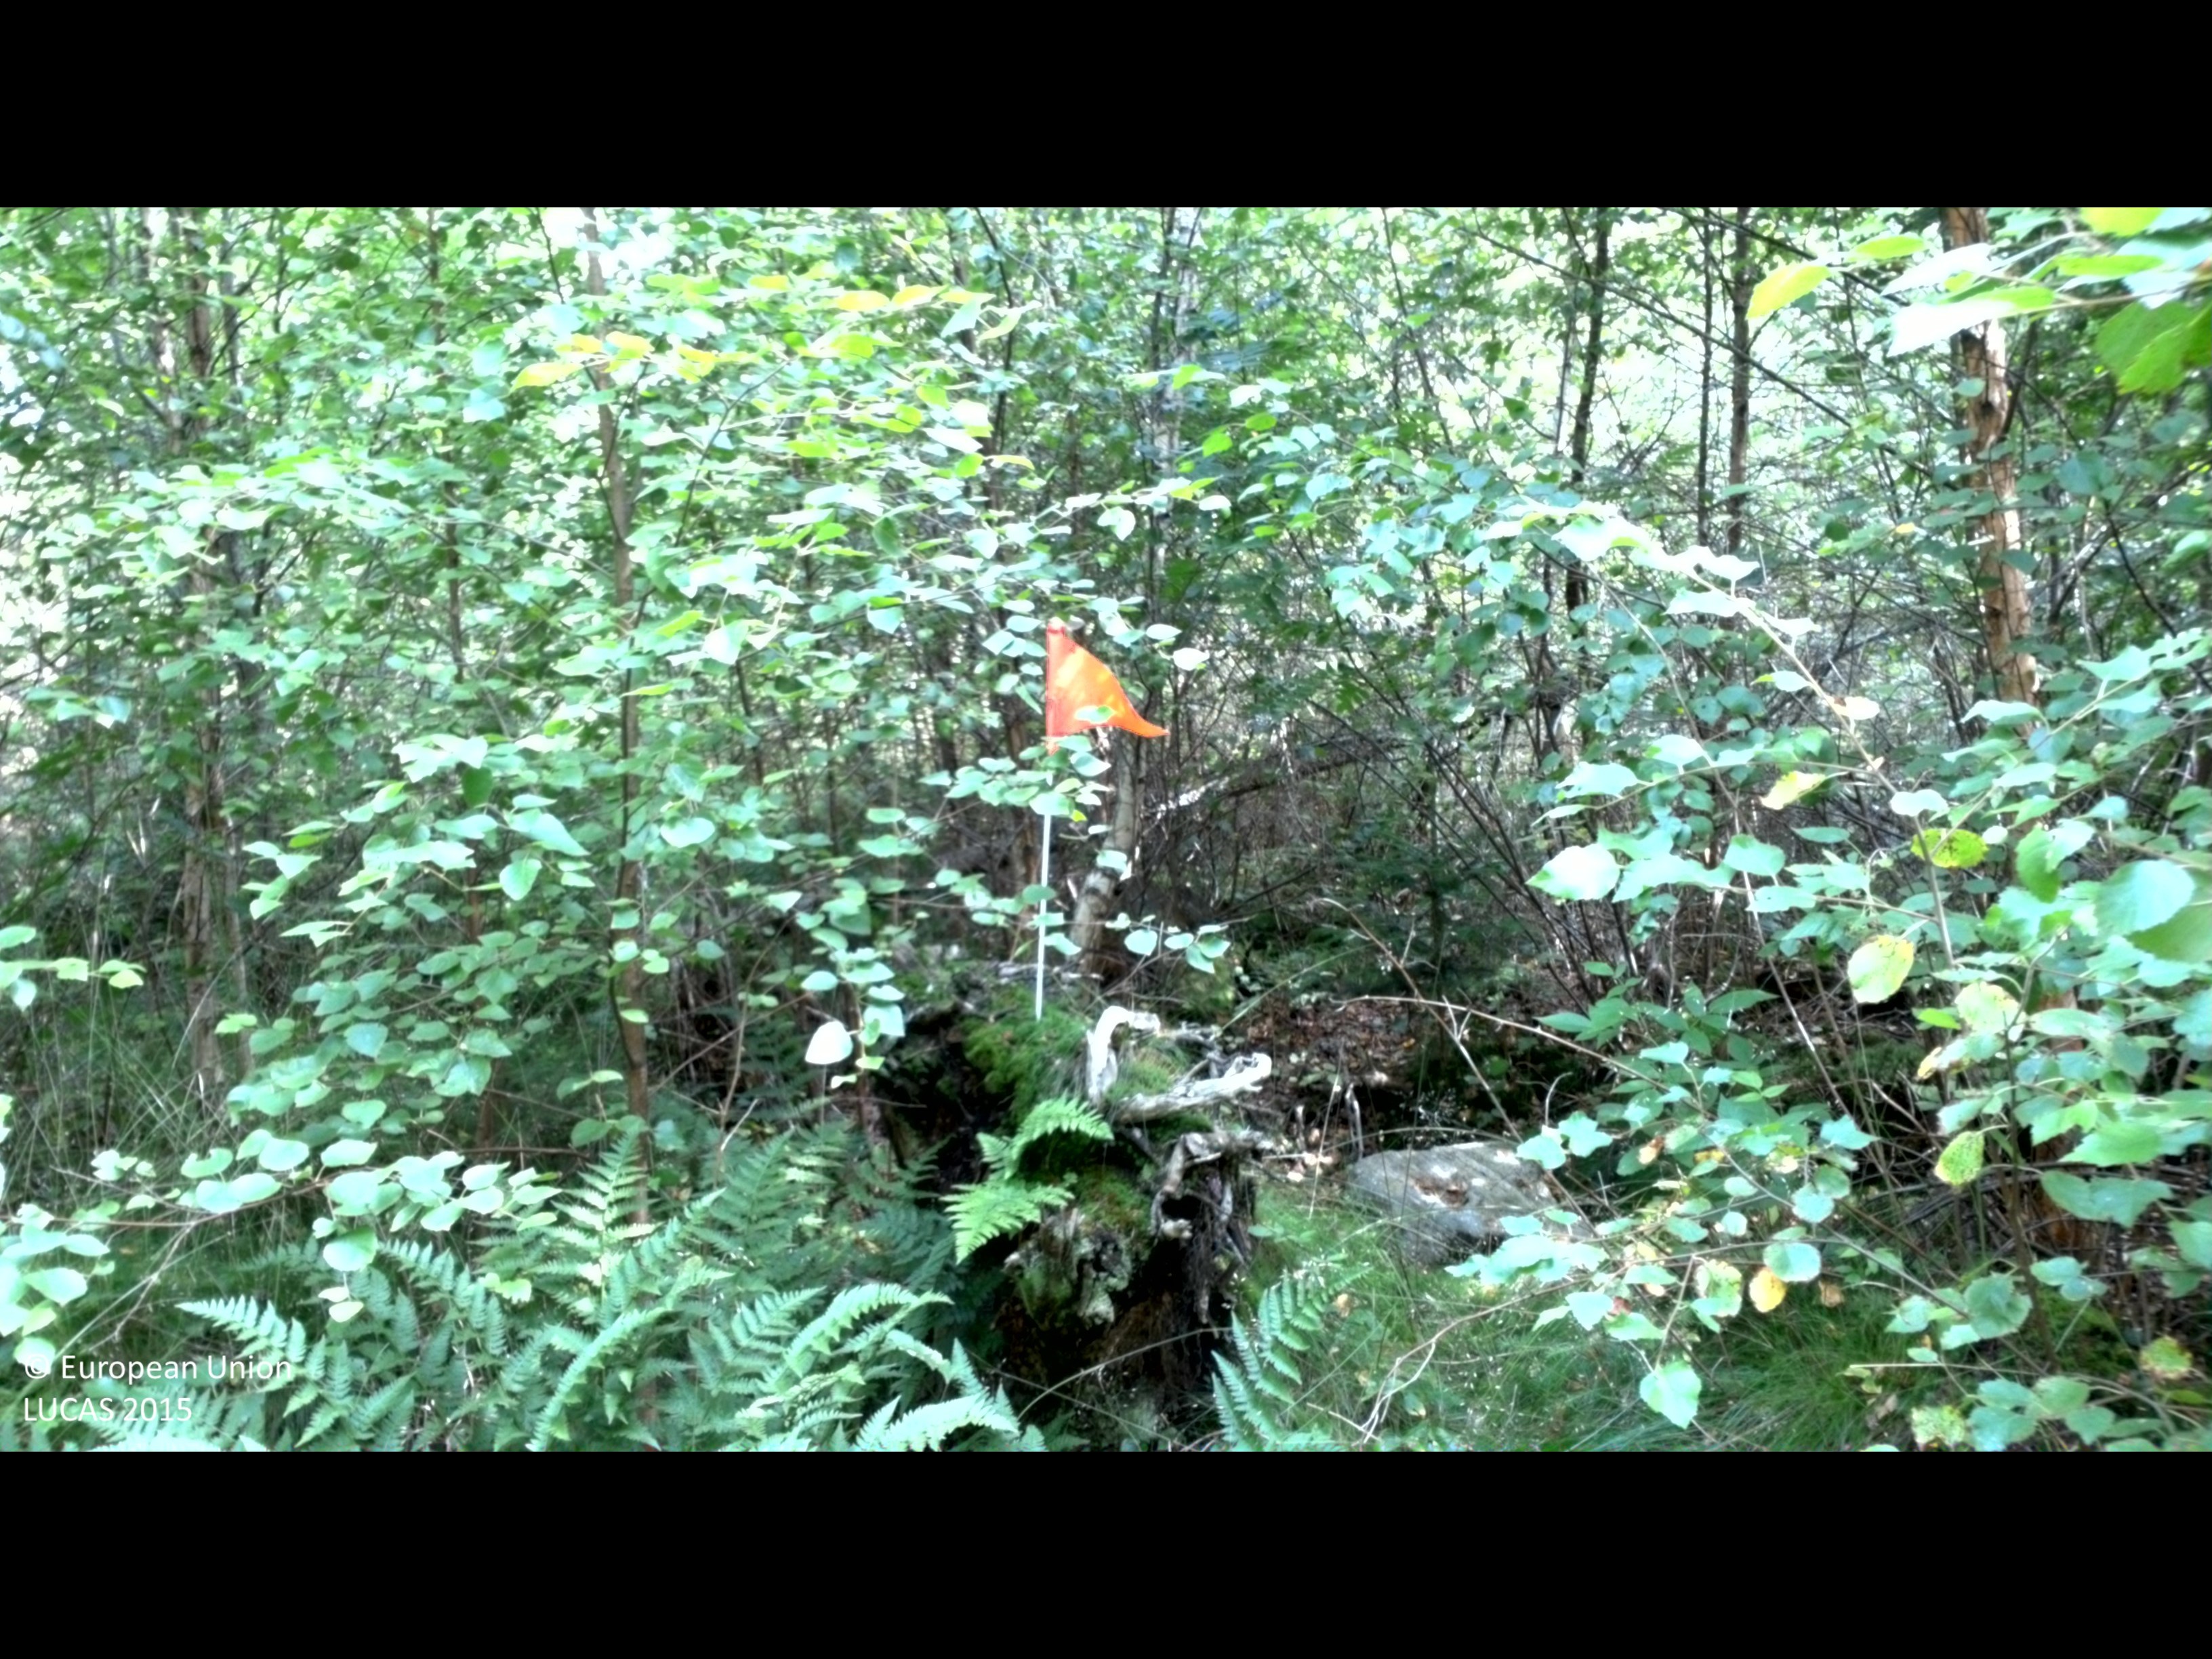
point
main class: Woodland
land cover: Broadleaved woodland
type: boreal forest
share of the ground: > 75 %
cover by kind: broadleaved forest trees 85 %, shrubs 10 %, herbaceous plants 5 %
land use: Forestry
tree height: < 5 m
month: August
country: SE
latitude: 56.4031
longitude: 14.3239
